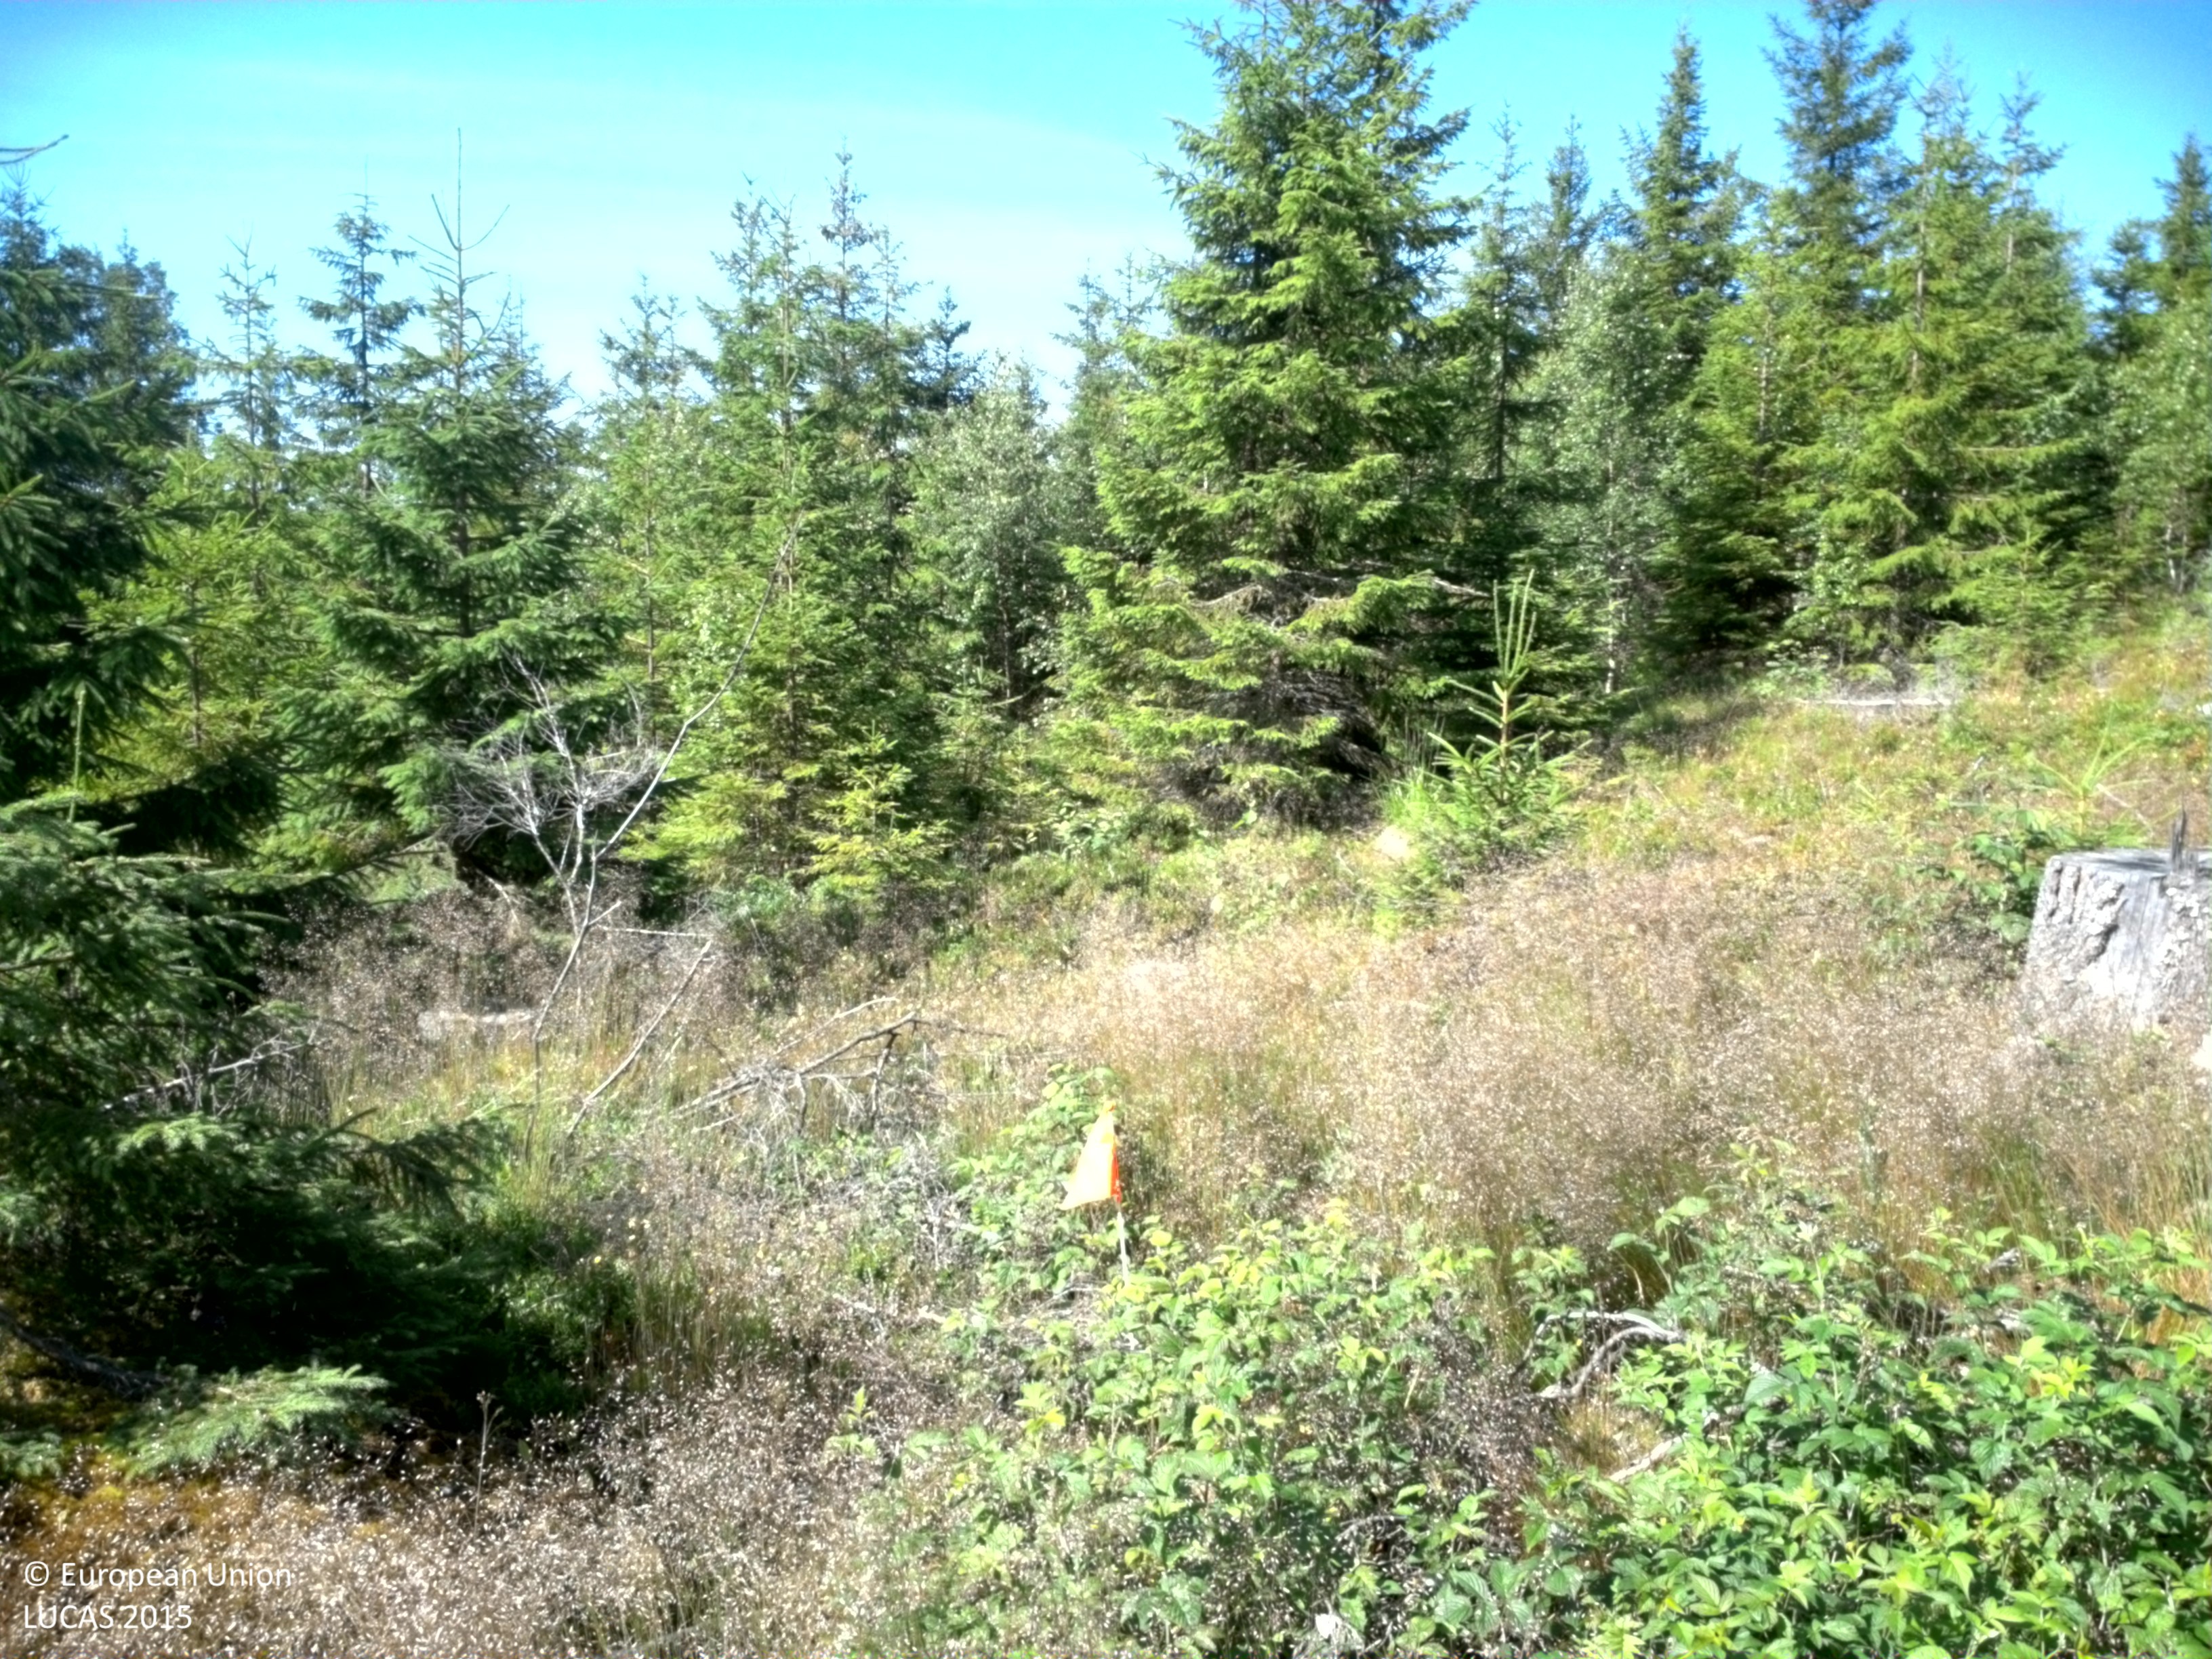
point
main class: Woodland
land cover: Spruce dominated coniferous woodland
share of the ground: 10 - 25 %
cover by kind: shrubs 45 %, herbaceous plants 40 %, coniferous forest trees 15 %
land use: Forestry
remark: Clear cut
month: July
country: SE
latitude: 59.7149
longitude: 14.4170
